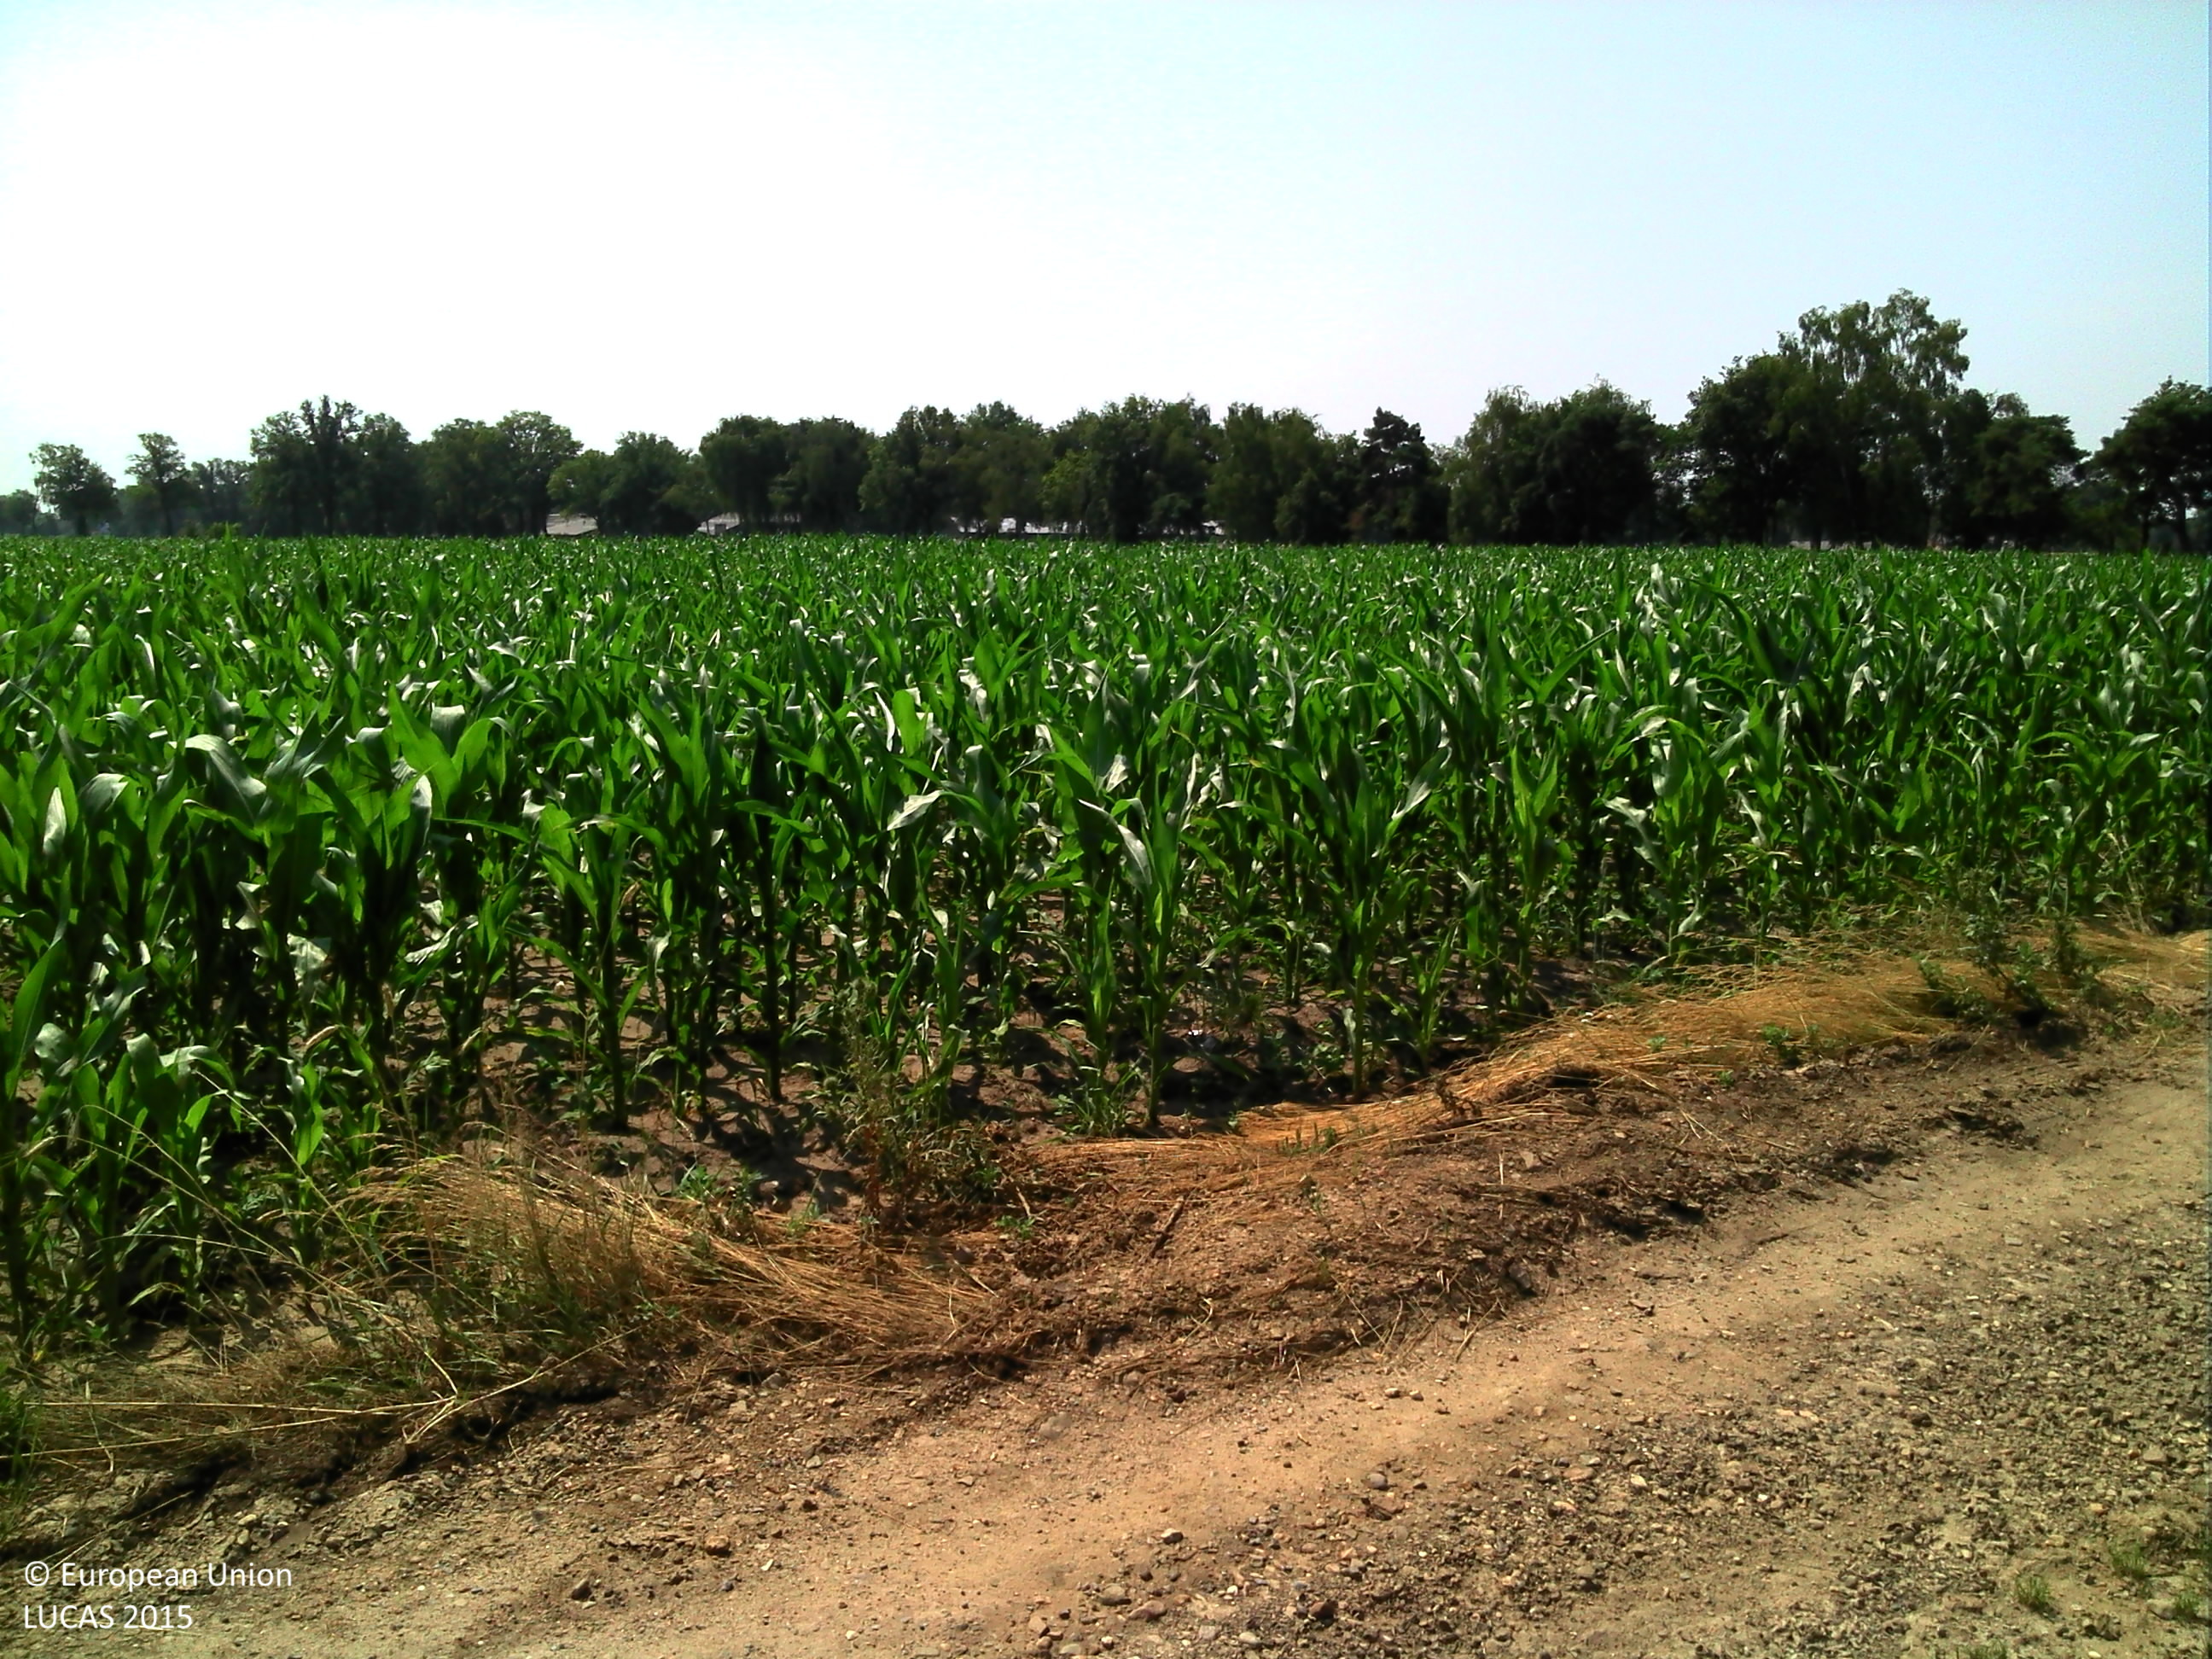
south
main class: Cropland
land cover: Maize
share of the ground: > 75 %
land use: Agriculture (excluding fallow land and kitchen gardens)
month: July
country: BE
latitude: 51.0826
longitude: 5.4157
